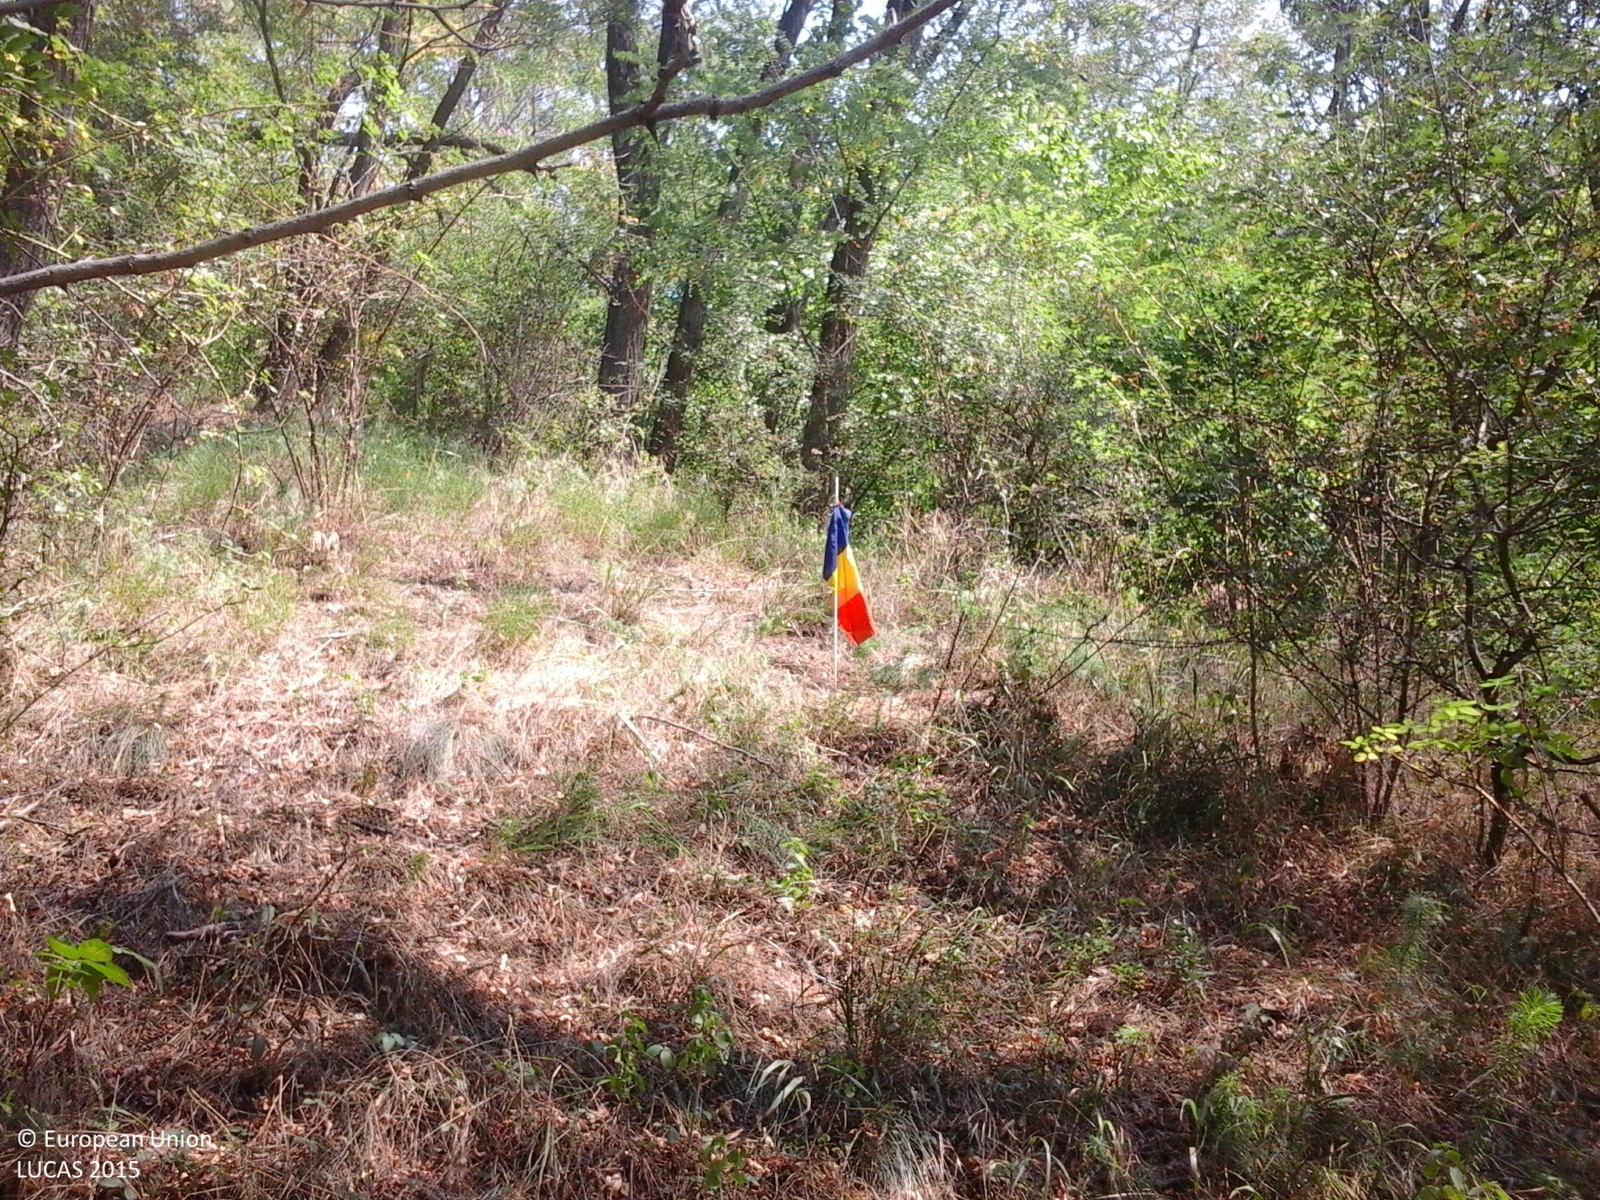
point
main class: Woodland
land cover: Broadleaved woodland
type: exotic forest
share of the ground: > 75 %
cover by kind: broadleaved forest trees 100 %
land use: Forestry
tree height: > 5 m
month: August
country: RO
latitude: 46.1436
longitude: 27.0673
